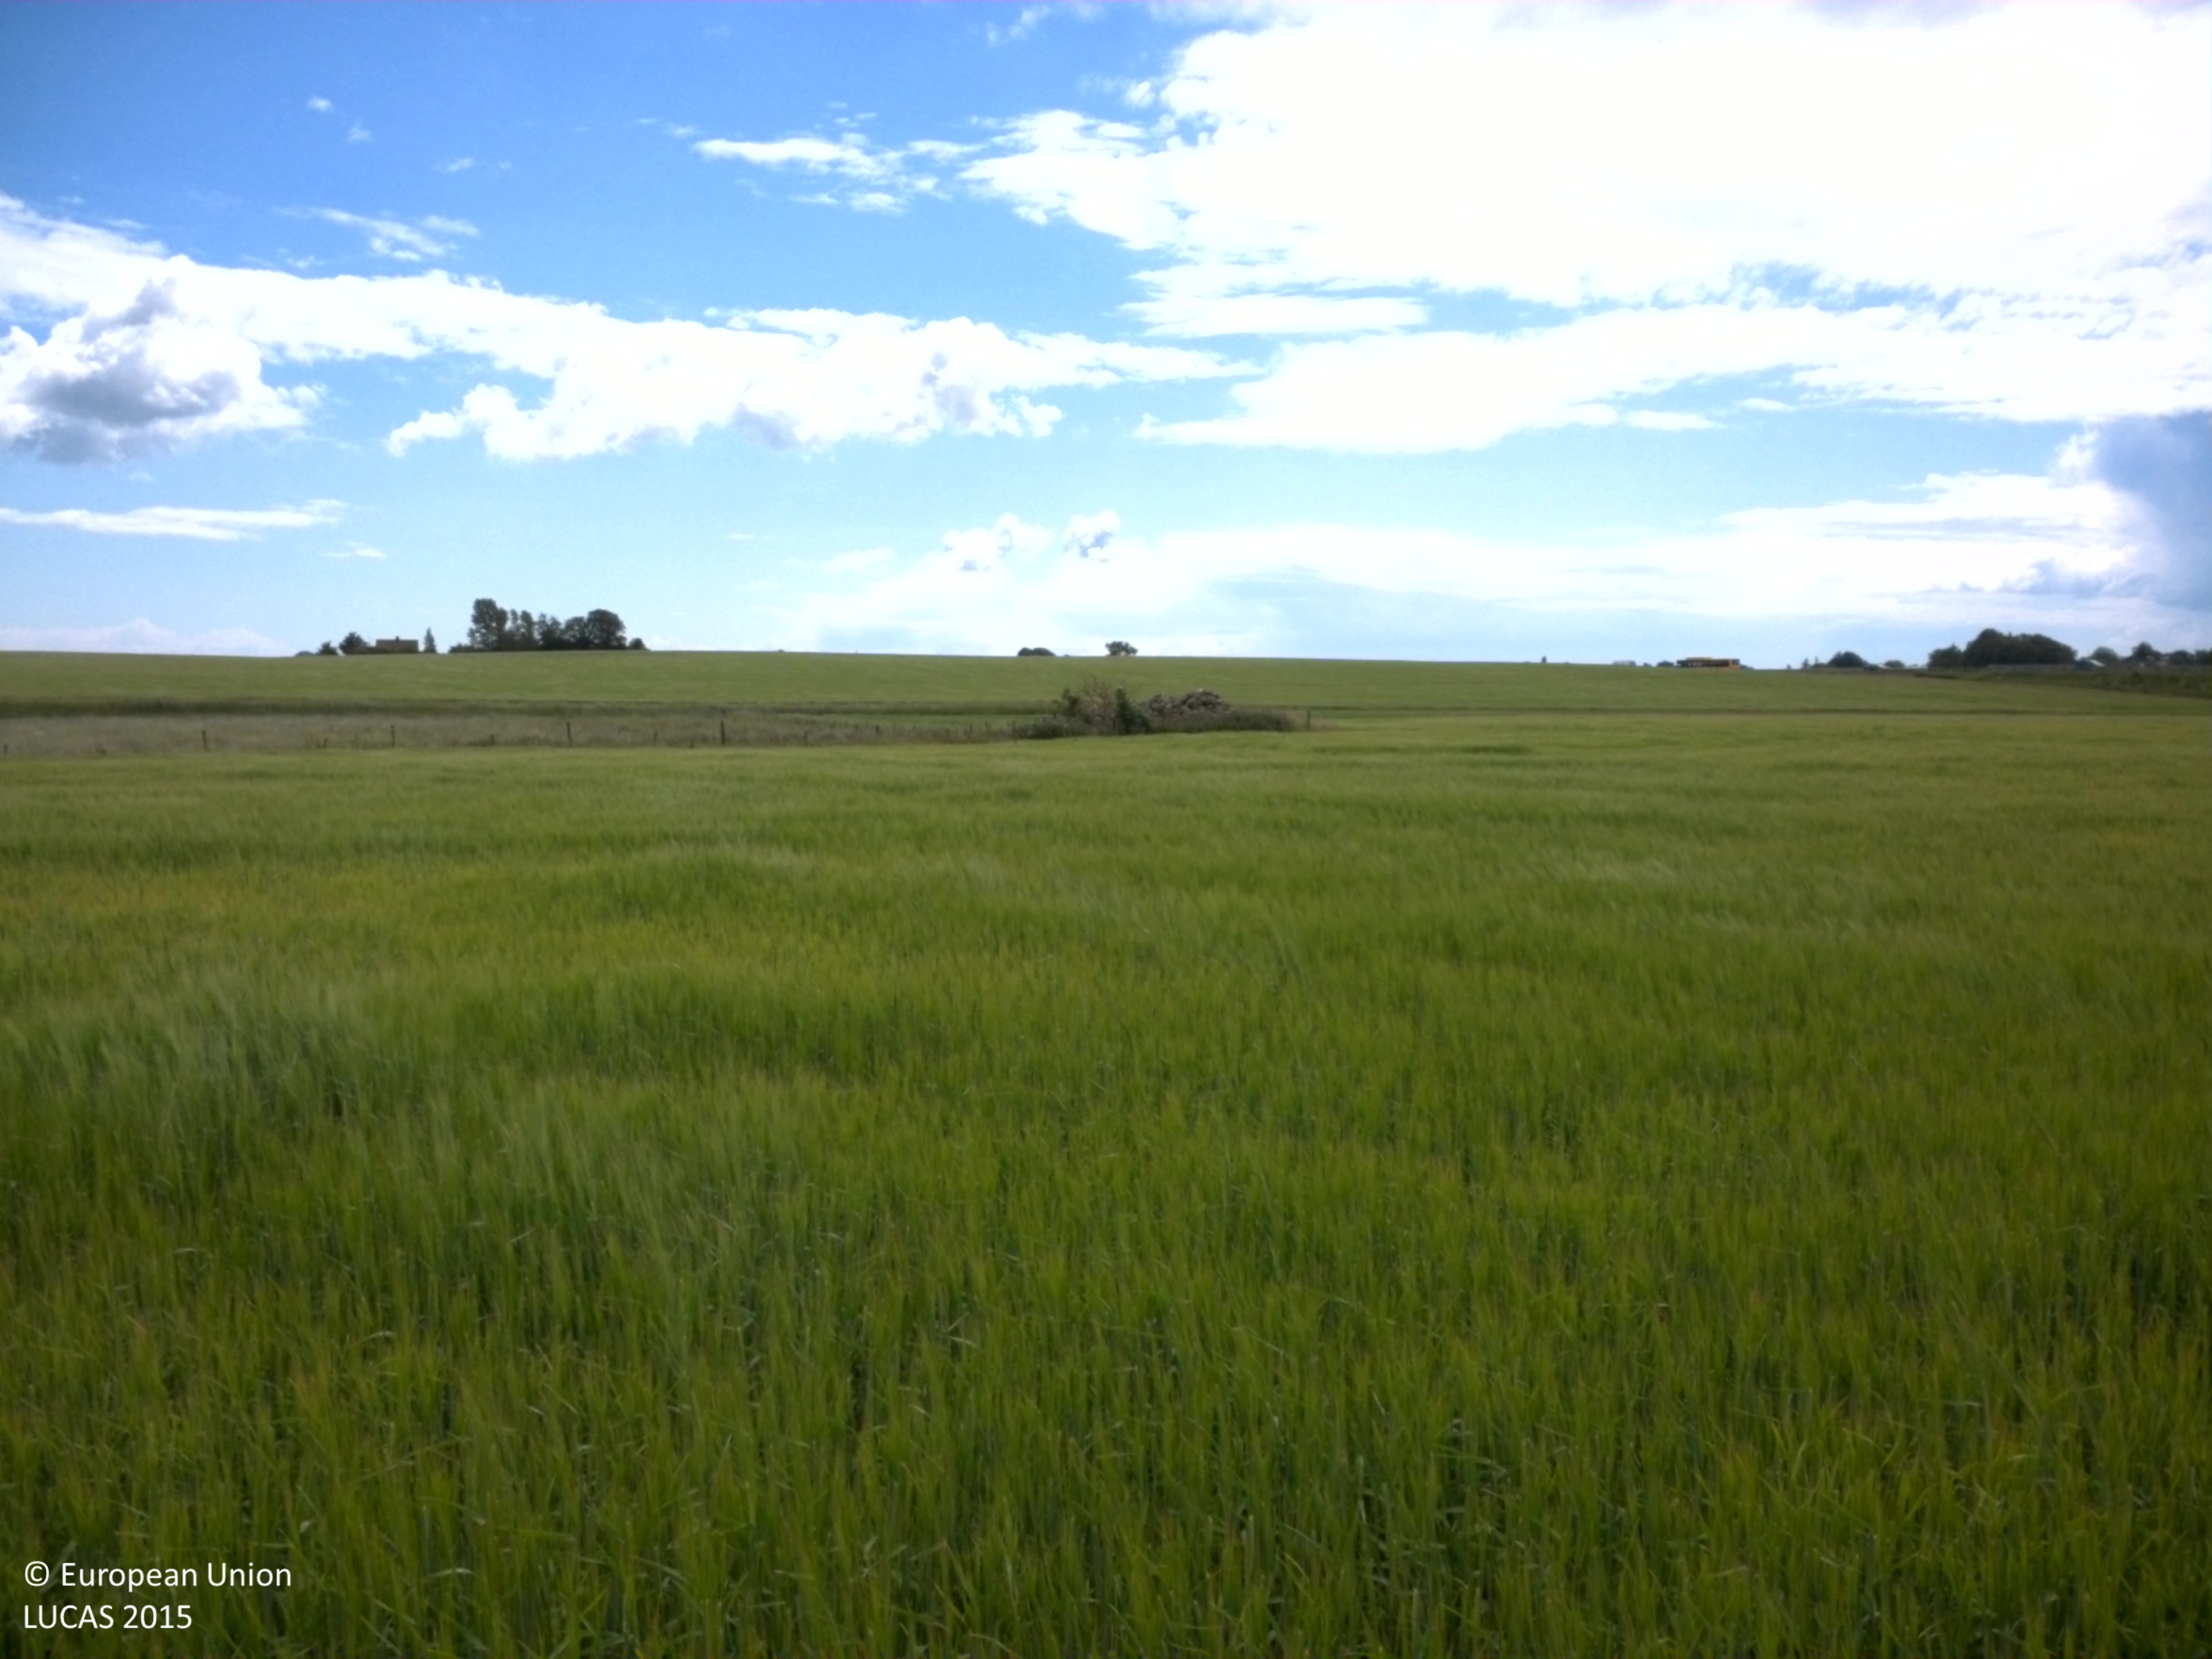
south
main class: Cropland
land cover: Barley
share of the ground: > 75 %
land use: Agriculture (excluding fallow land and kitchen gardens)
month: June
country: SE
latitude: 55.5046
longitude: 13.0221
